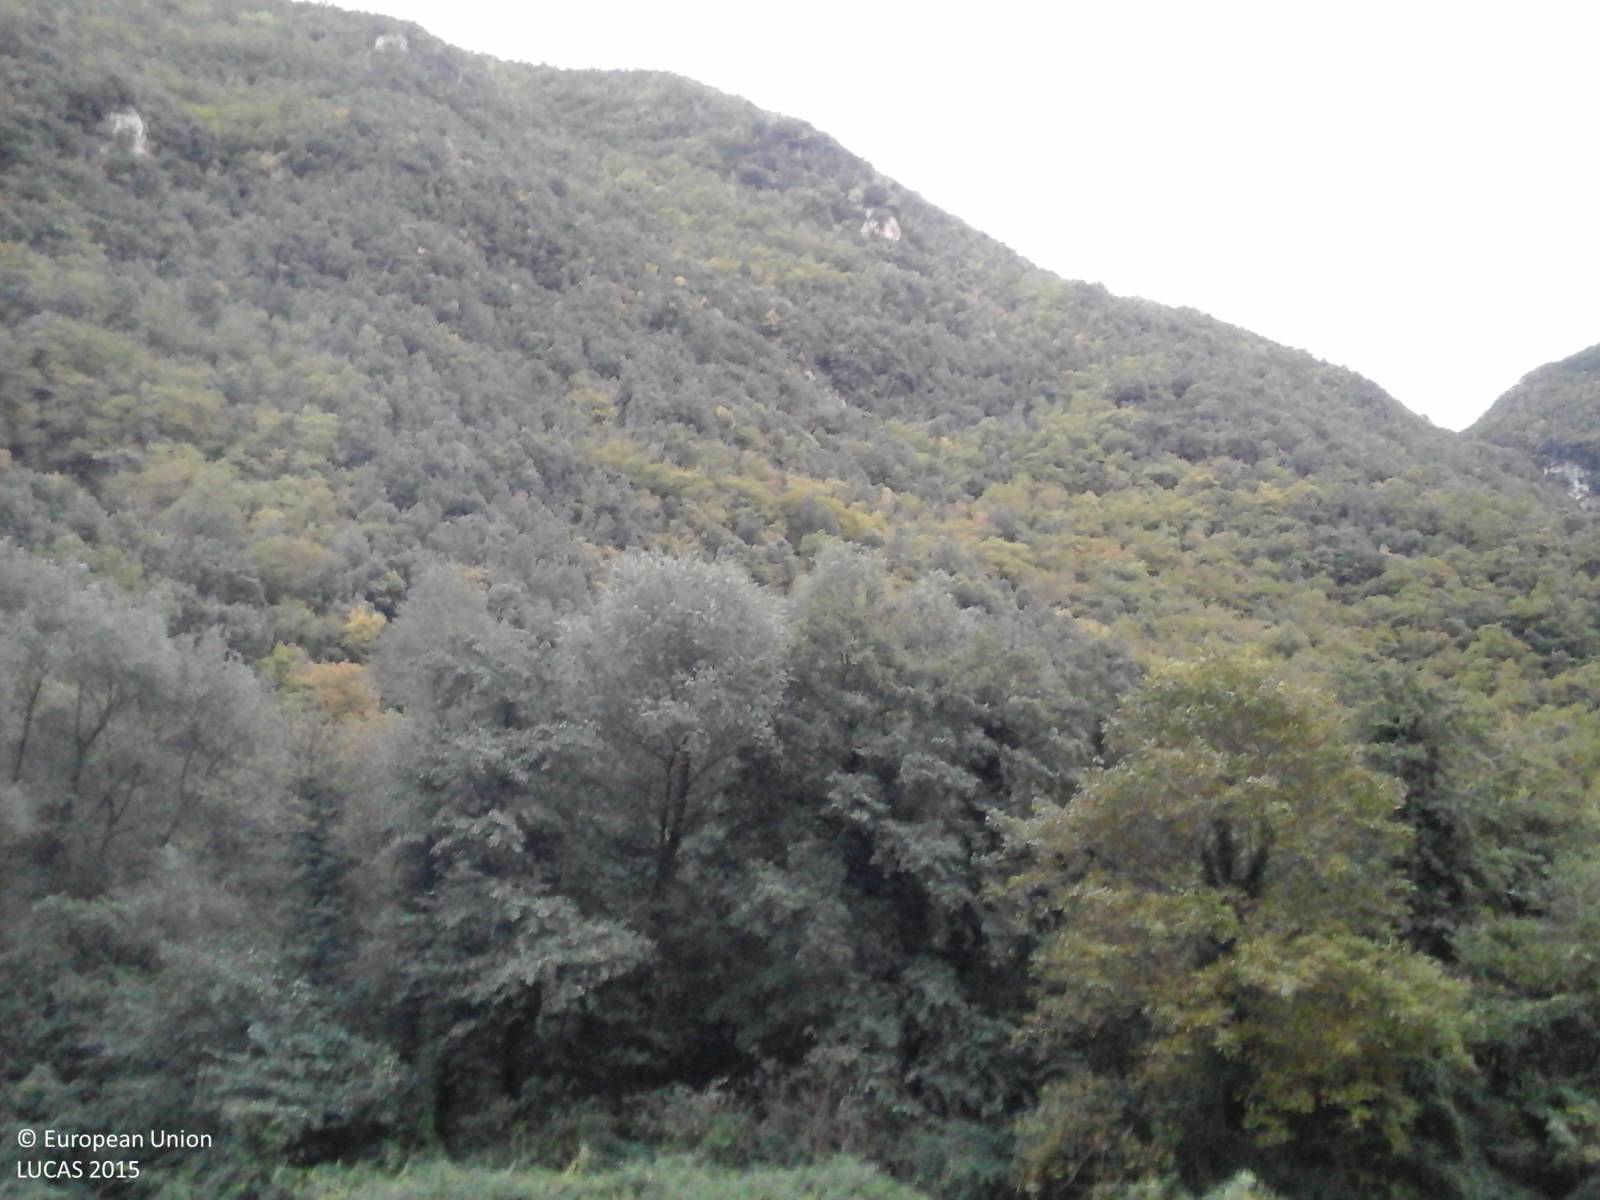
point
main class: Woodland
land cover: Broadleaved woodland
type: thermophilous deciduous forest
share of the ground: > 75 %
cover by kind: broadleaved forest trees 90 %, shrubs 10 %
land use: Forestry
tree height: > 5 m
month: October
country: IT
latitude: 42.7935
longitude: 12.8888
